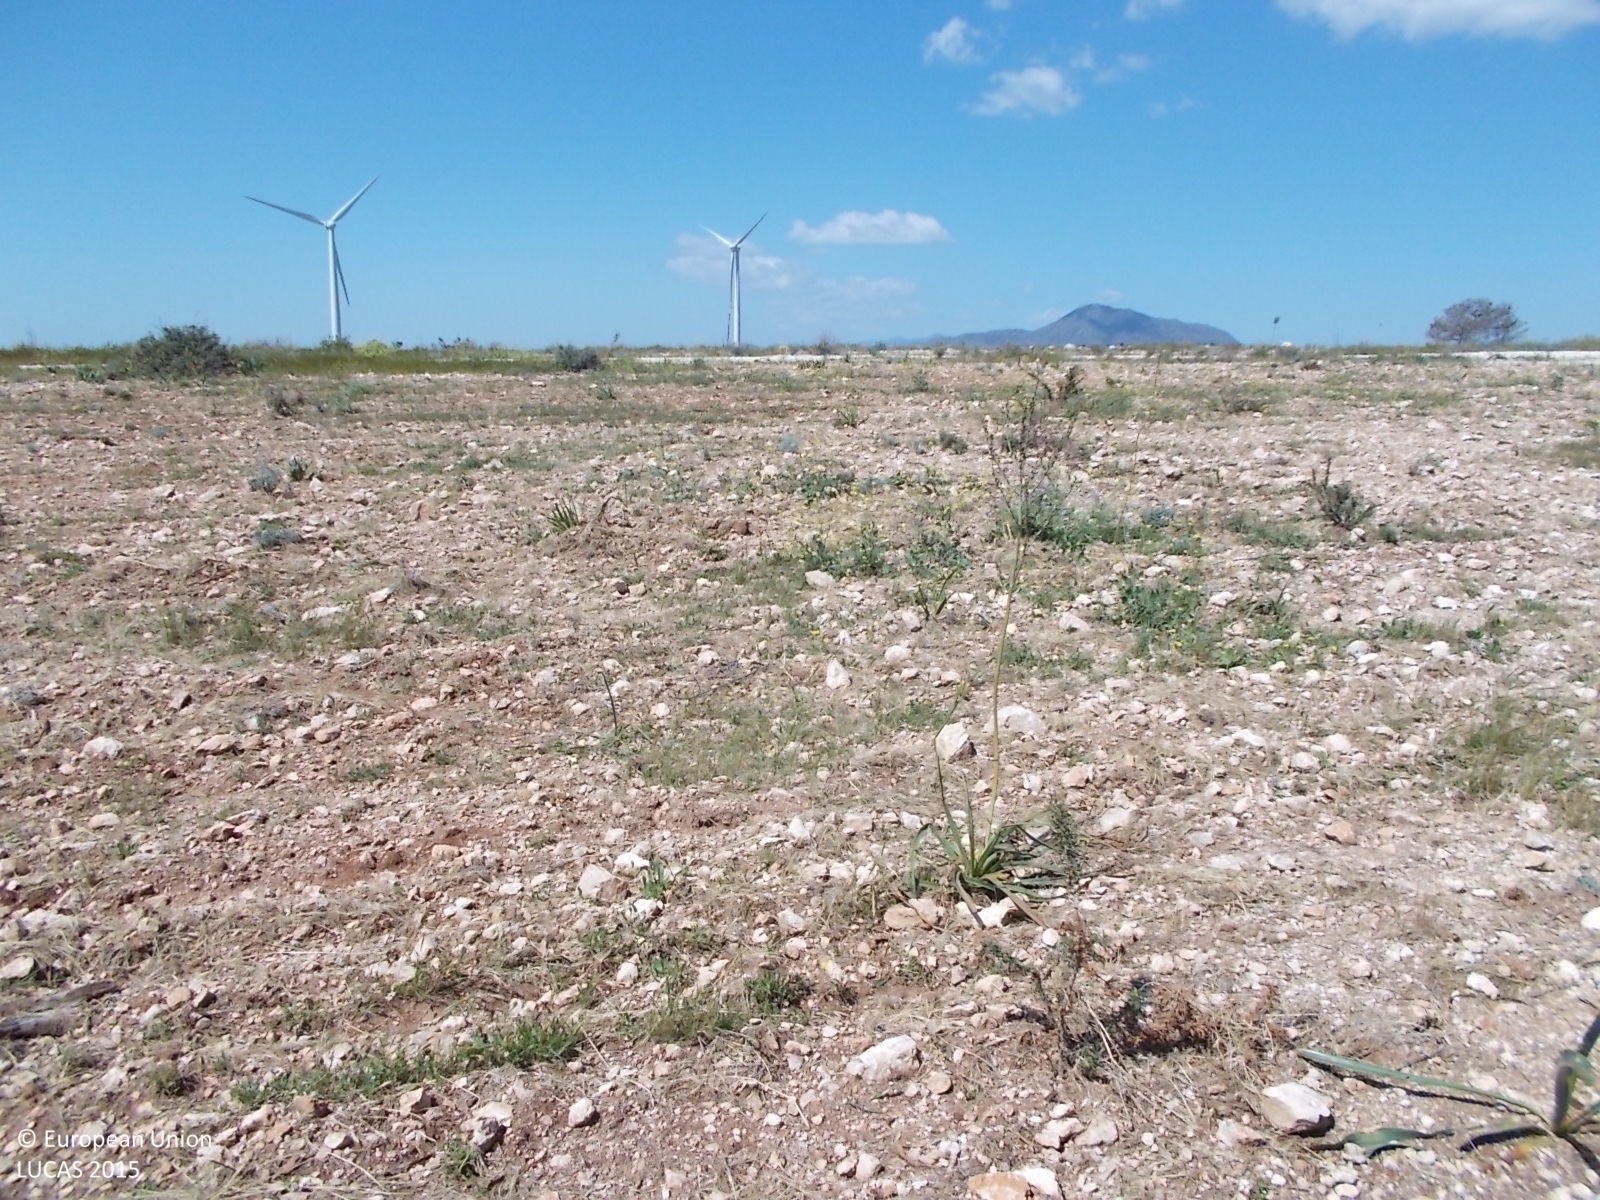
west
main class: Shrubland
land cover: Shrubland without tree cover
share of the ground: 10 - 25 %
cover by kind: unconsolidated bare surface 55 %, herbaceous plants 25 %, shrubs 20 %
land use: Energy production
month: April
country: CY
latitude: 34.8651
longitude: 33.5228
